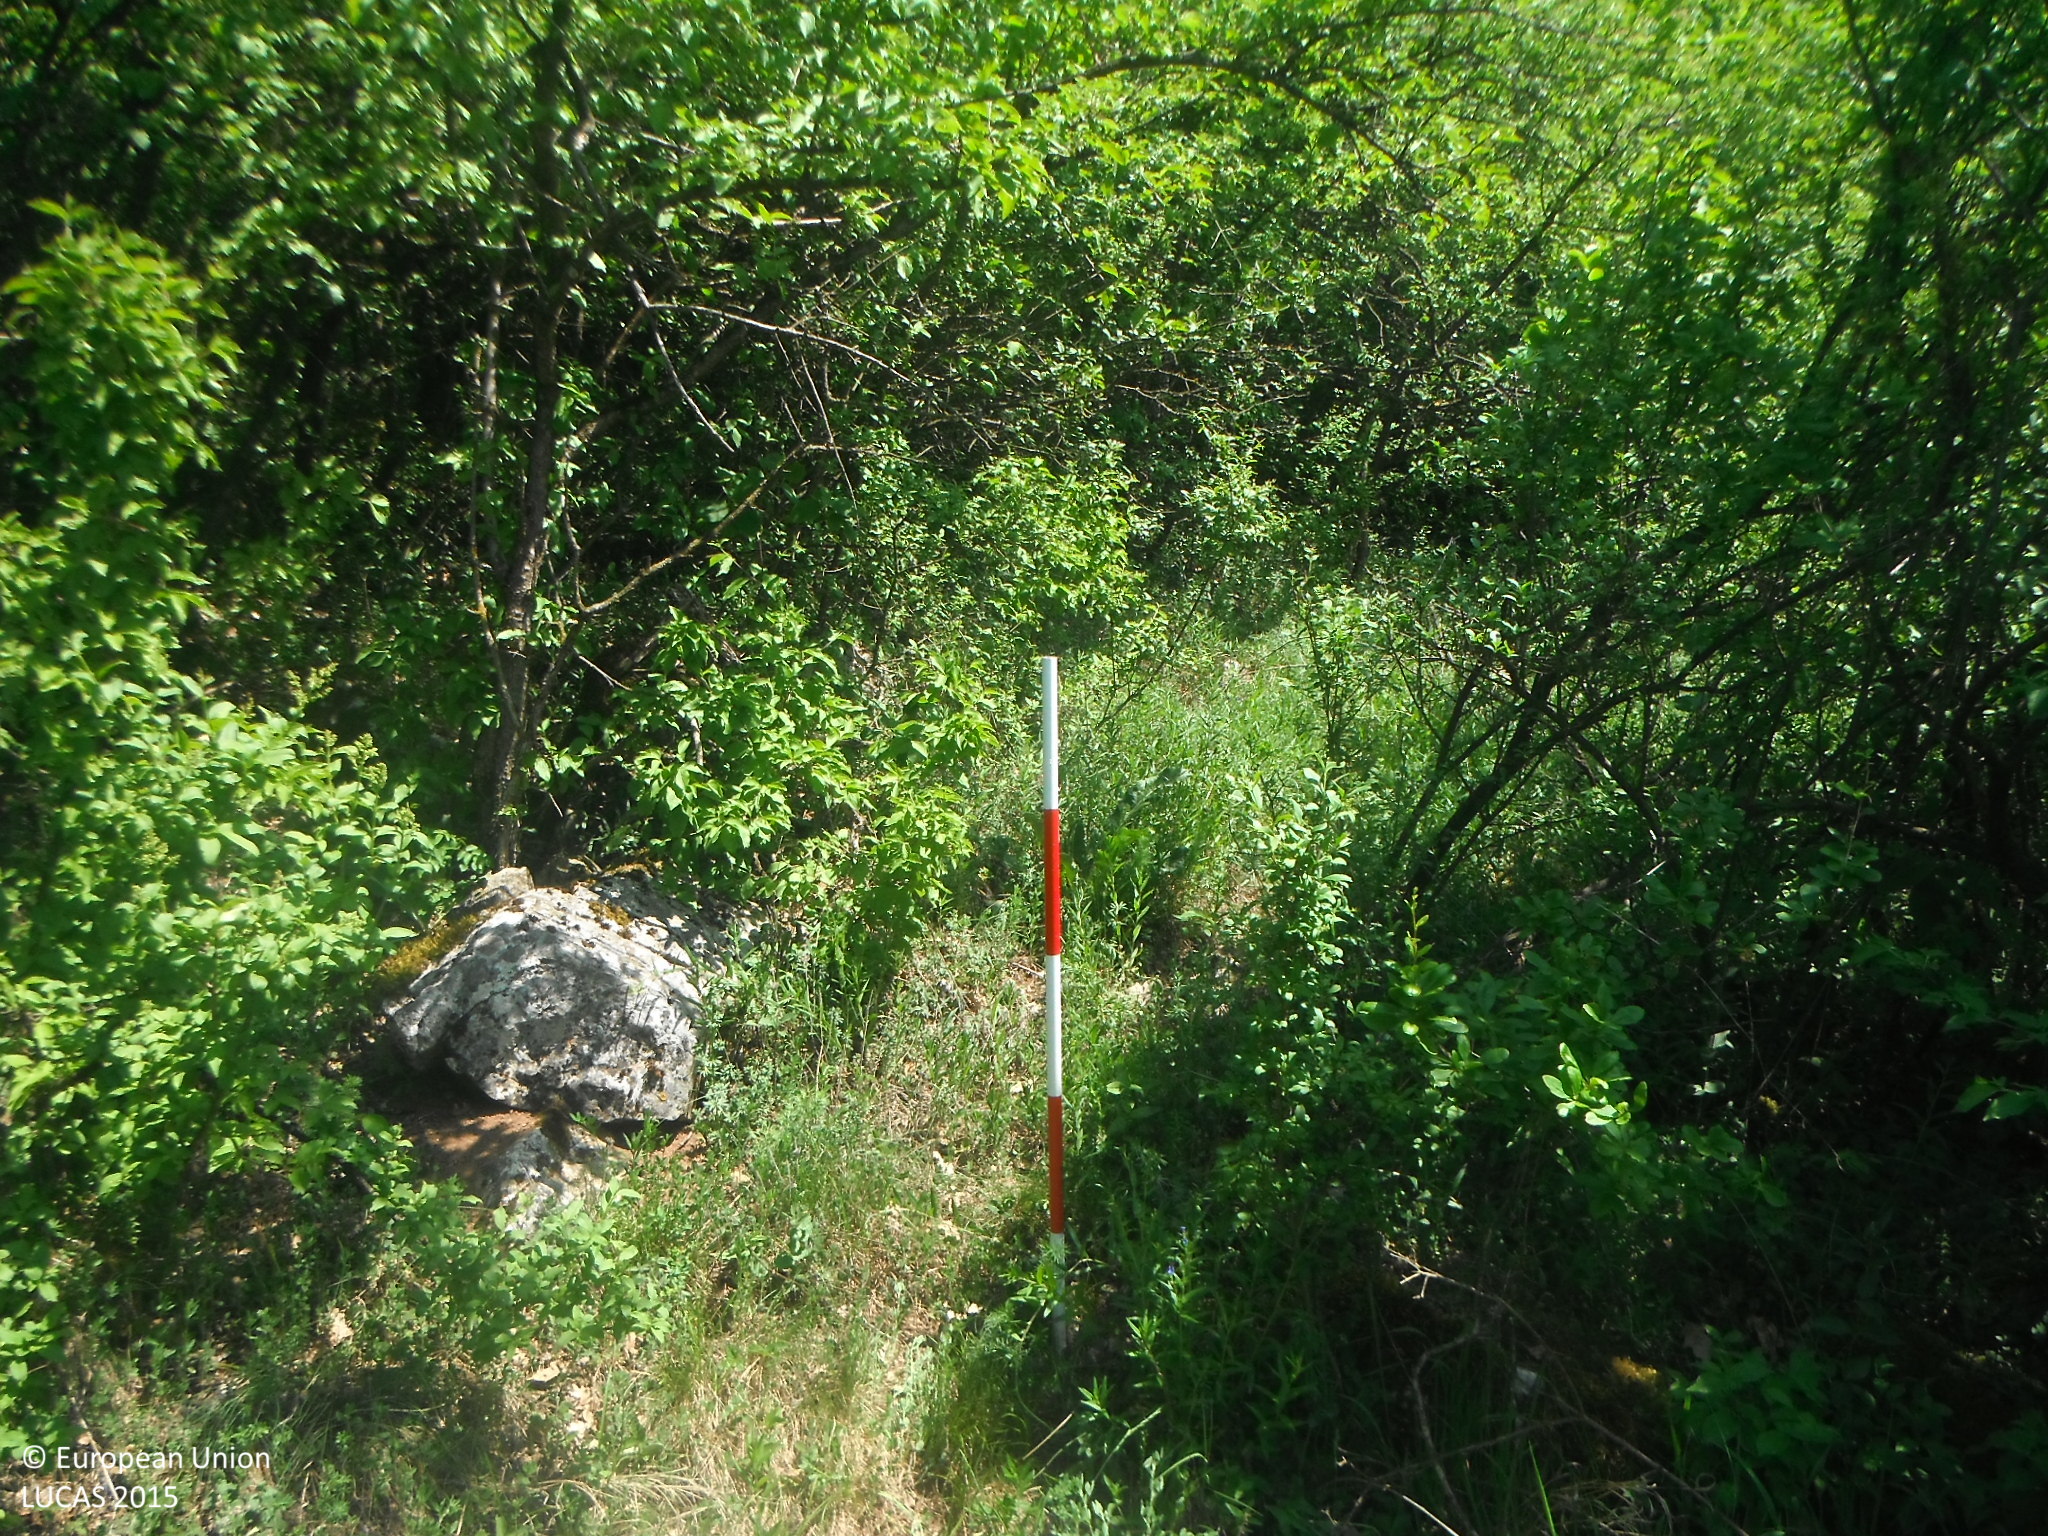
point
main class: Woodland
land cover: Broadleaved woodland
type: mesophytic deciduous forest
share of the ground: 10 - 25 %
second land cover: Shrubland without tree cover
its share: 50 - 75 %
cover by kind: shrubs 60 %, broadleaved forest trees 25 %, herbaceous plants 15 %
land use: Semi-natural and natural areas not in use
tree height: > 5 m
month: May
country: SK
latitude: 48.6247
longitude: 20.9071
